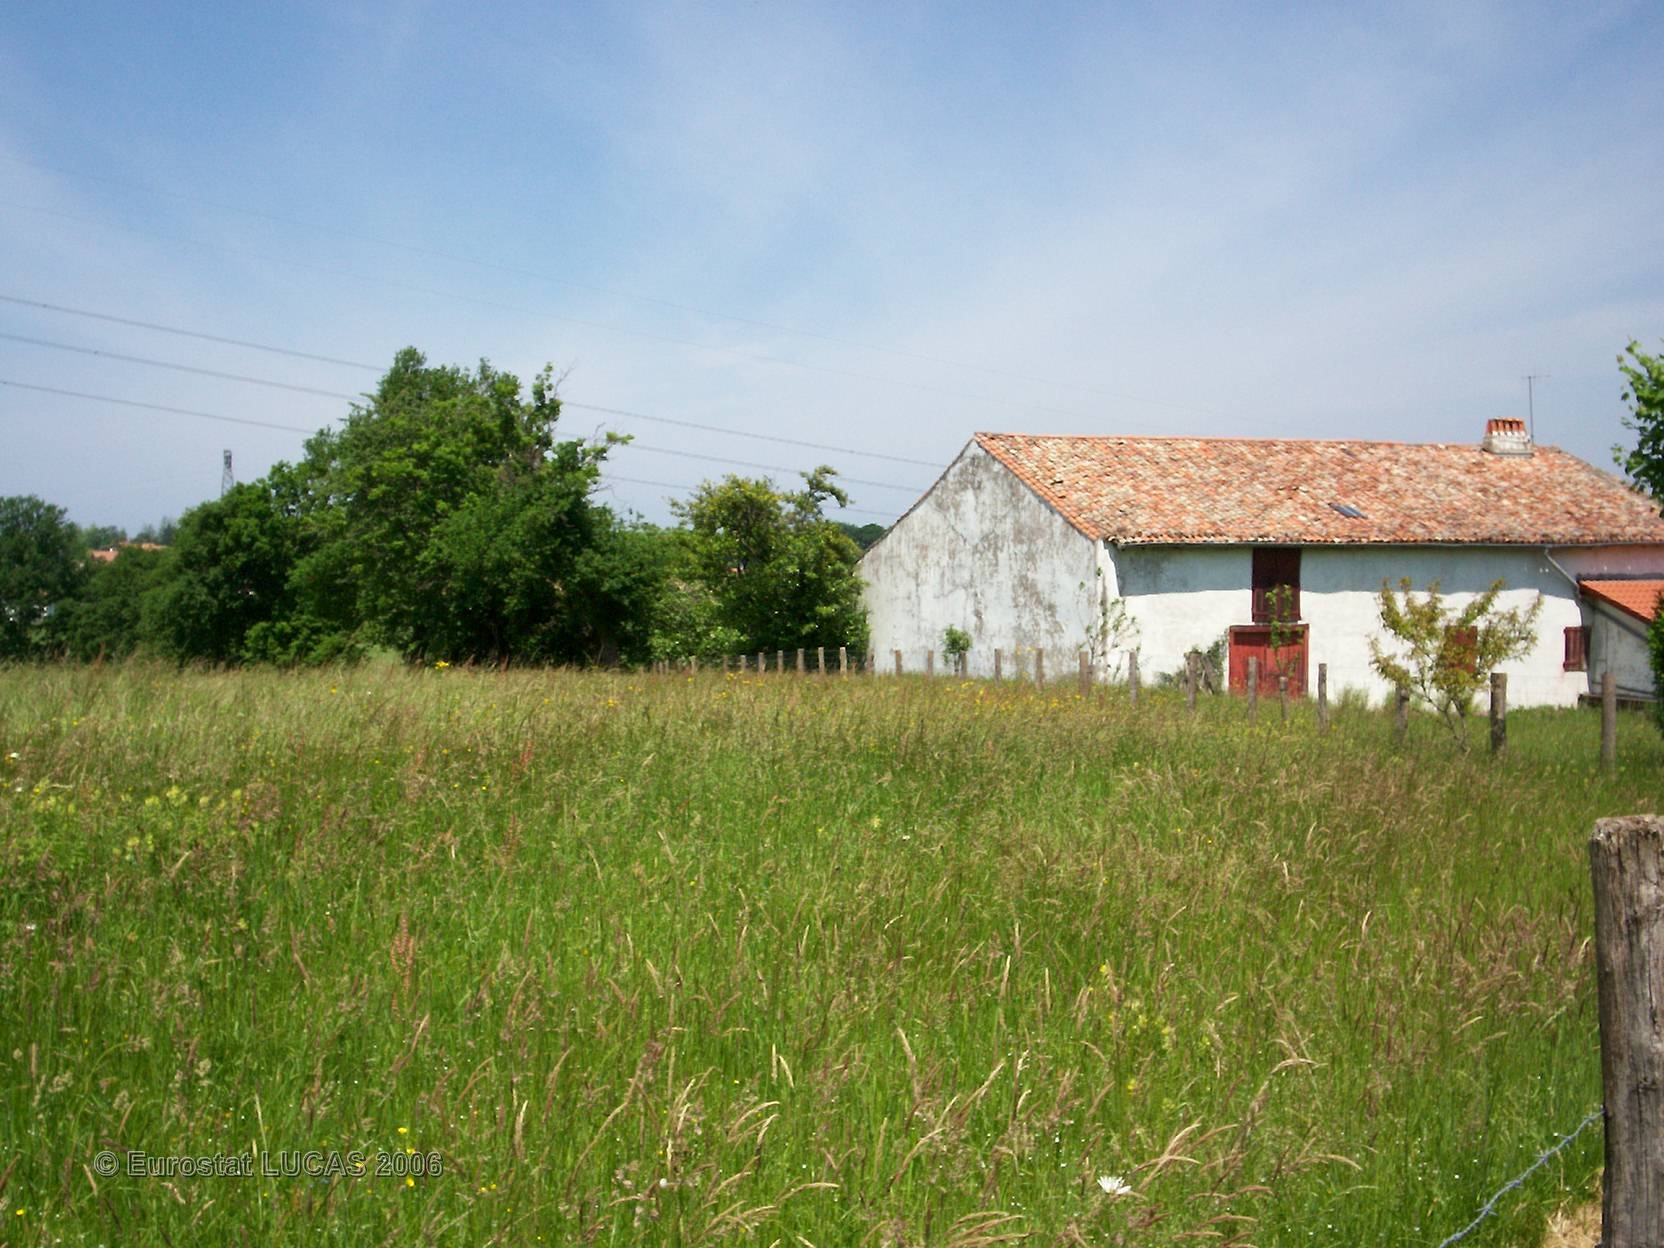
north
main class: Grassland
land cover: Grassland without tree/shrub cover
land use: Agriculture (excluding fallow land and kitchen gardens)
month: May
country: FR
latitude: 43.3401
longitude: -1.7008
